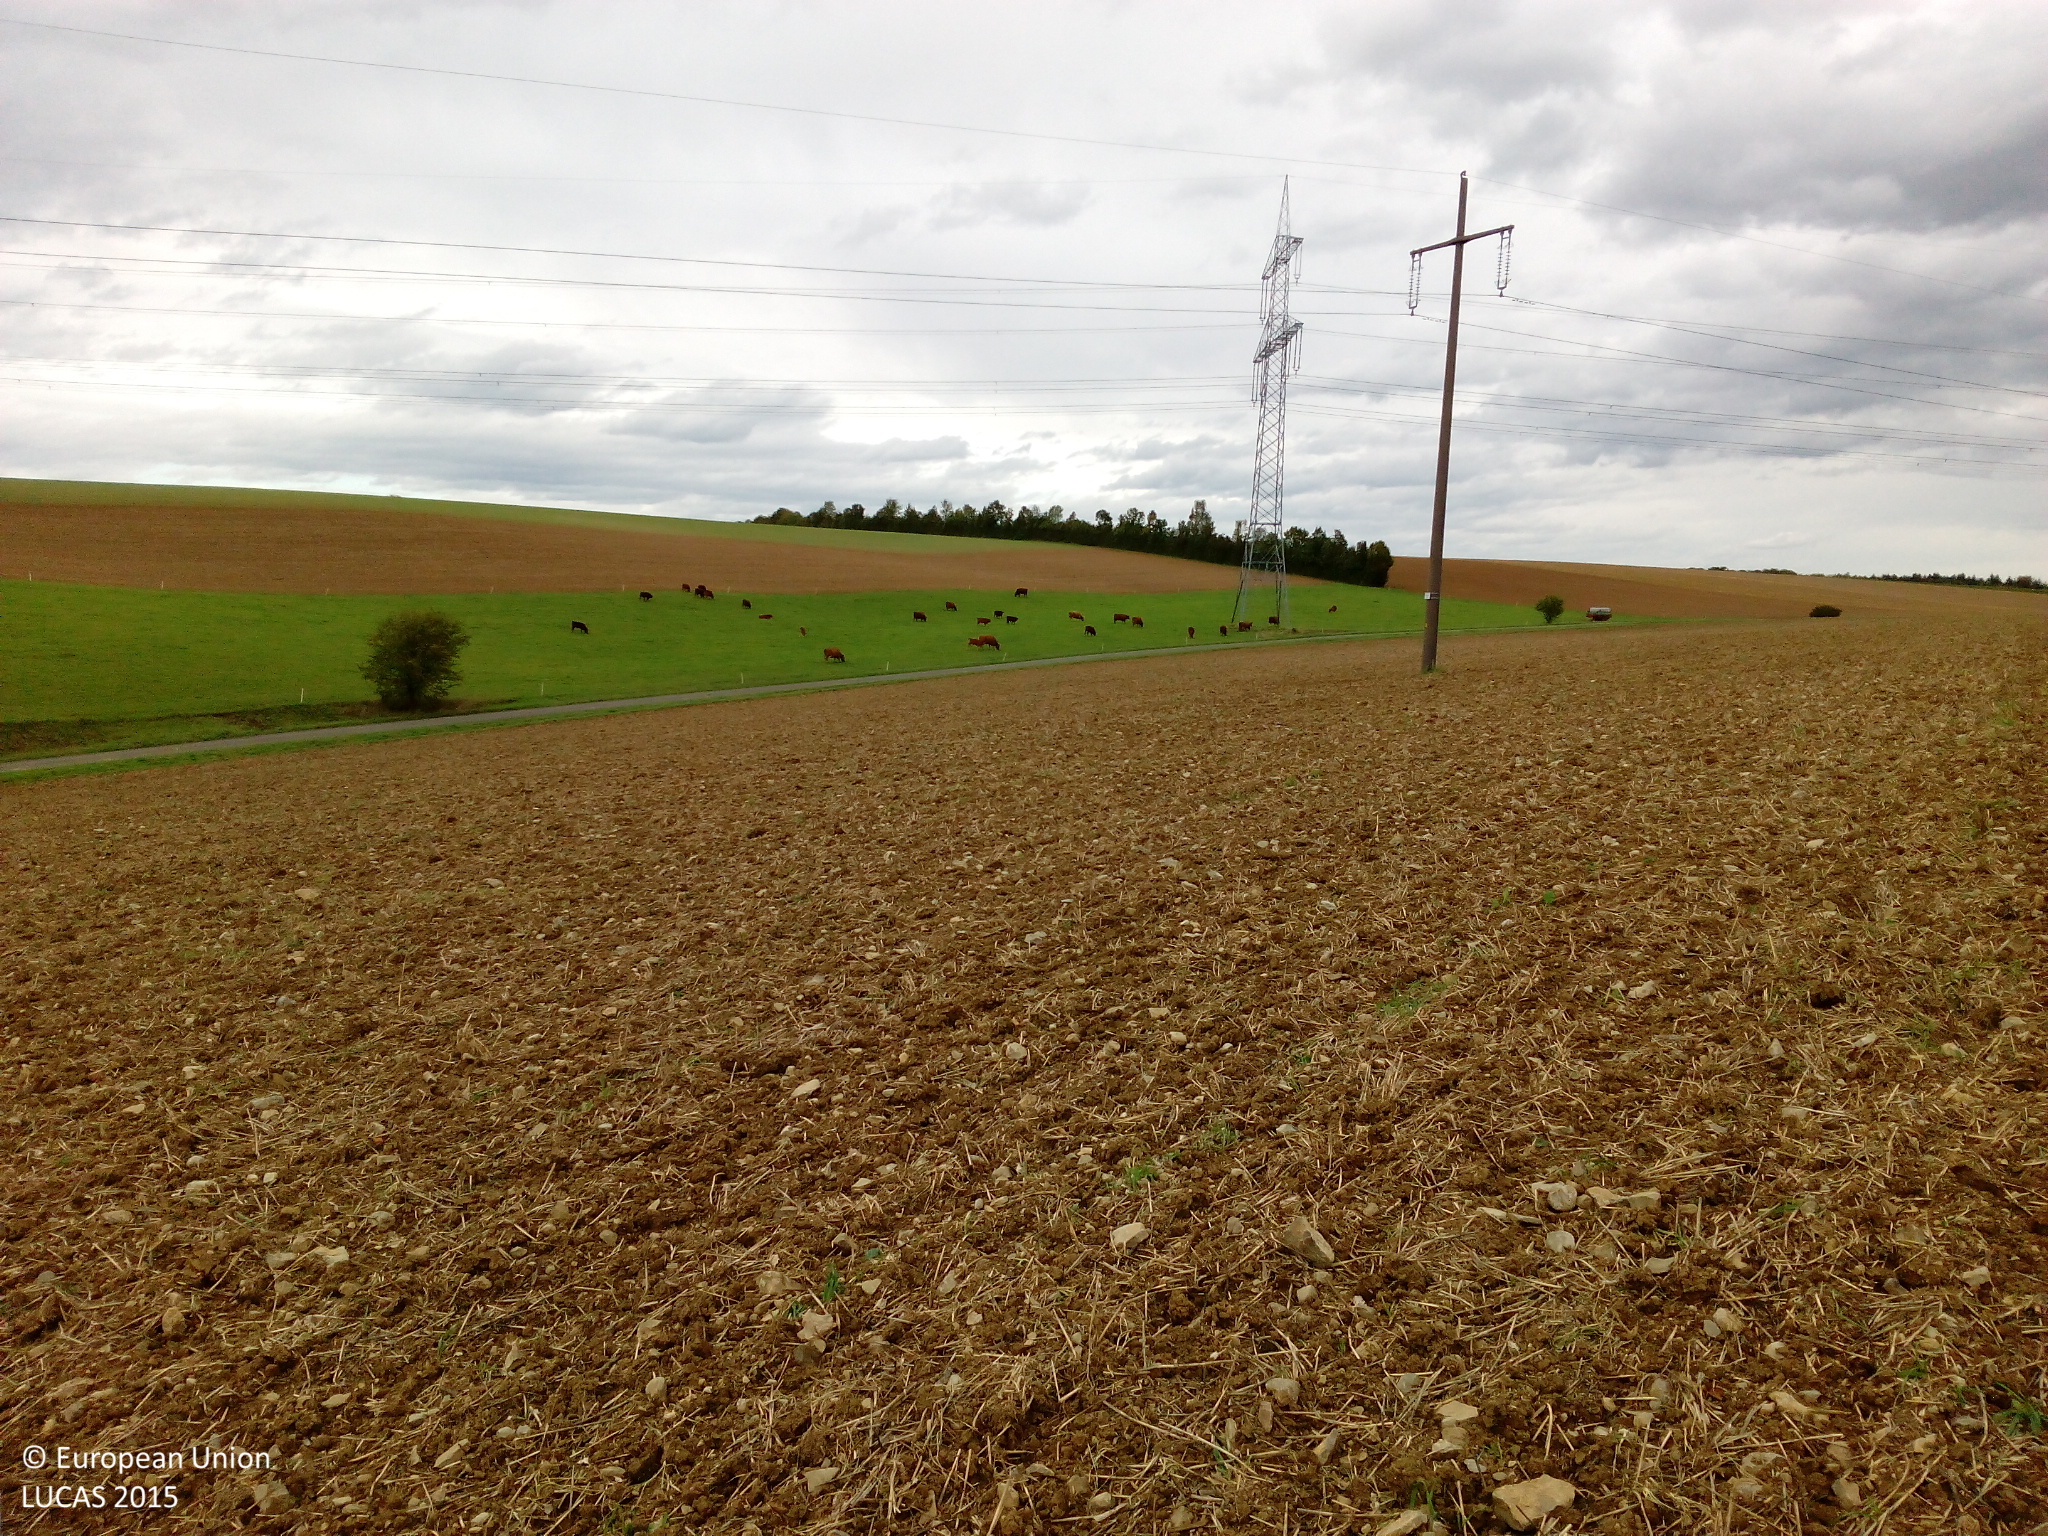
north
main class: Cropland
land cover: Common wheat
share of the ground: 10 - 25 %
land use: Agriculture (excluding fallow land and kitchen gardens)
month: September
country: DE
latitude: 49.9864
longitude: 9.9303
